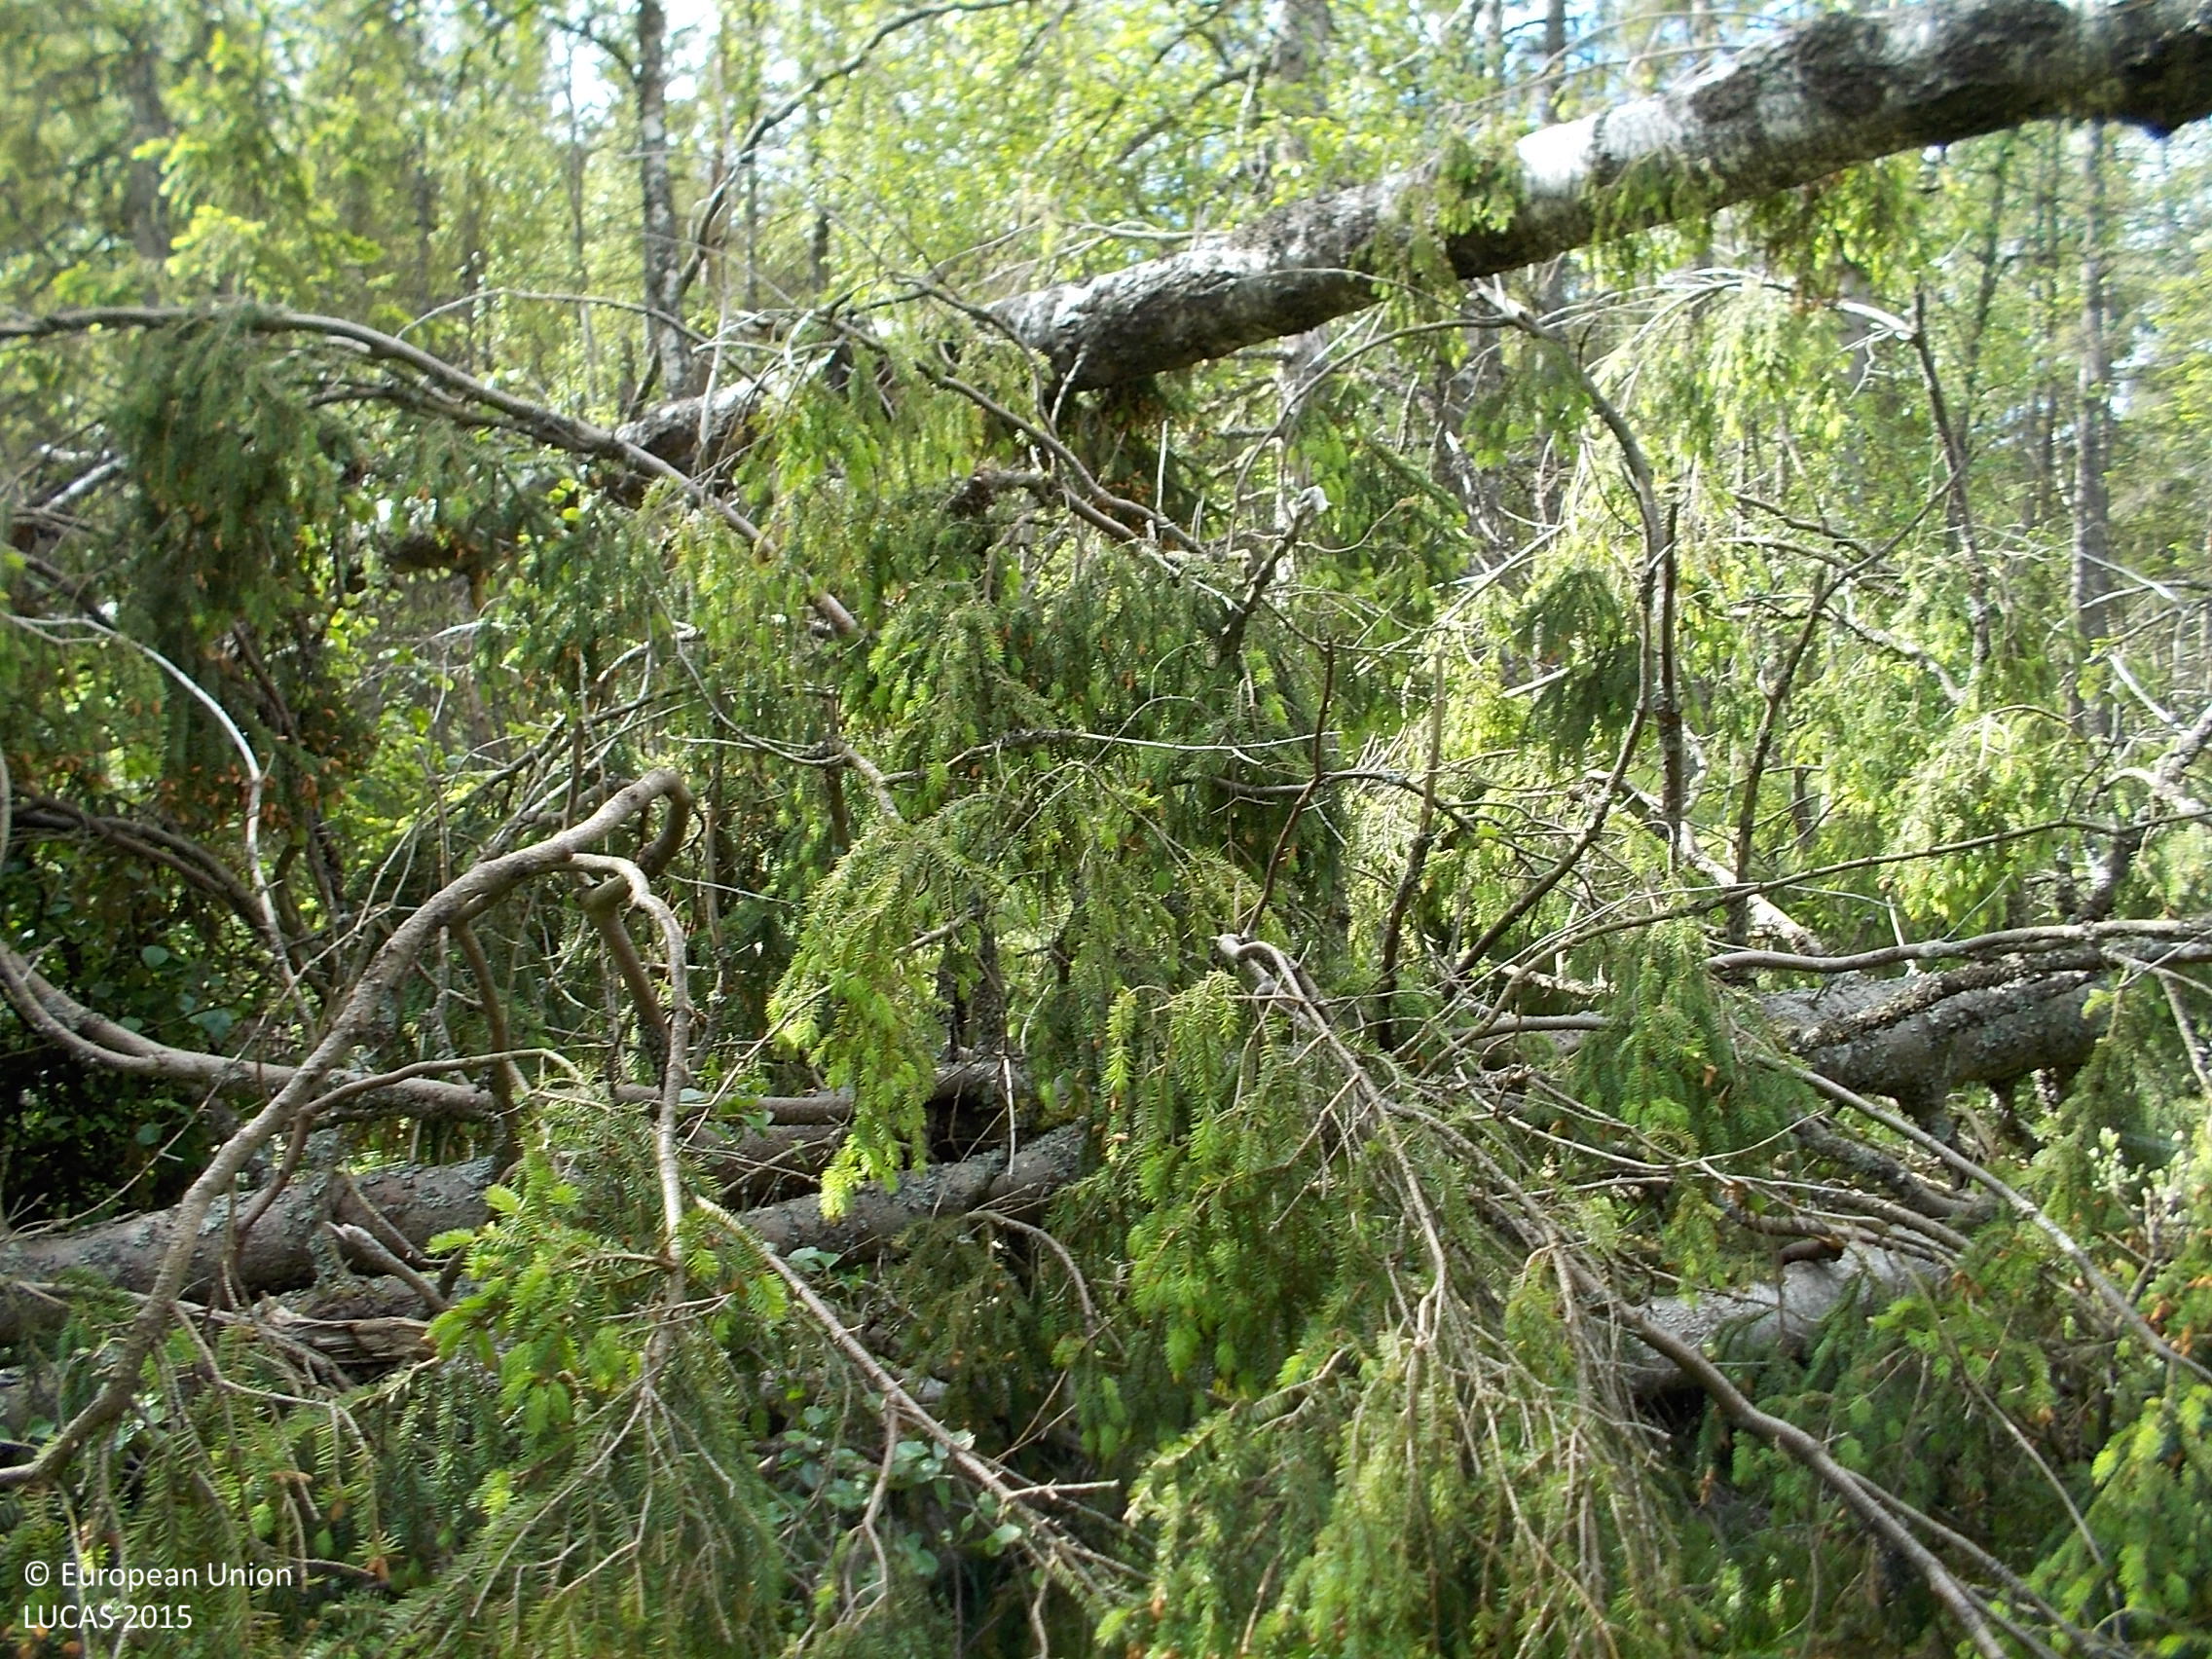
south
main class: Woodland
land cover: Spruce dominated mixed woodland
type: mire and swamp forests
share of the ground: 50 - 75 %
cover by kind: coniferous forest trees 40 %, broadleaved forest trees 20 %, herbaceous plants 20 %, lichens and mosses 20 %
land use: Semi-natural and natural areas not in use
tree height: > 5 m
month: June
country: SE
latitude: 57.6799
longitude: 13.0979
